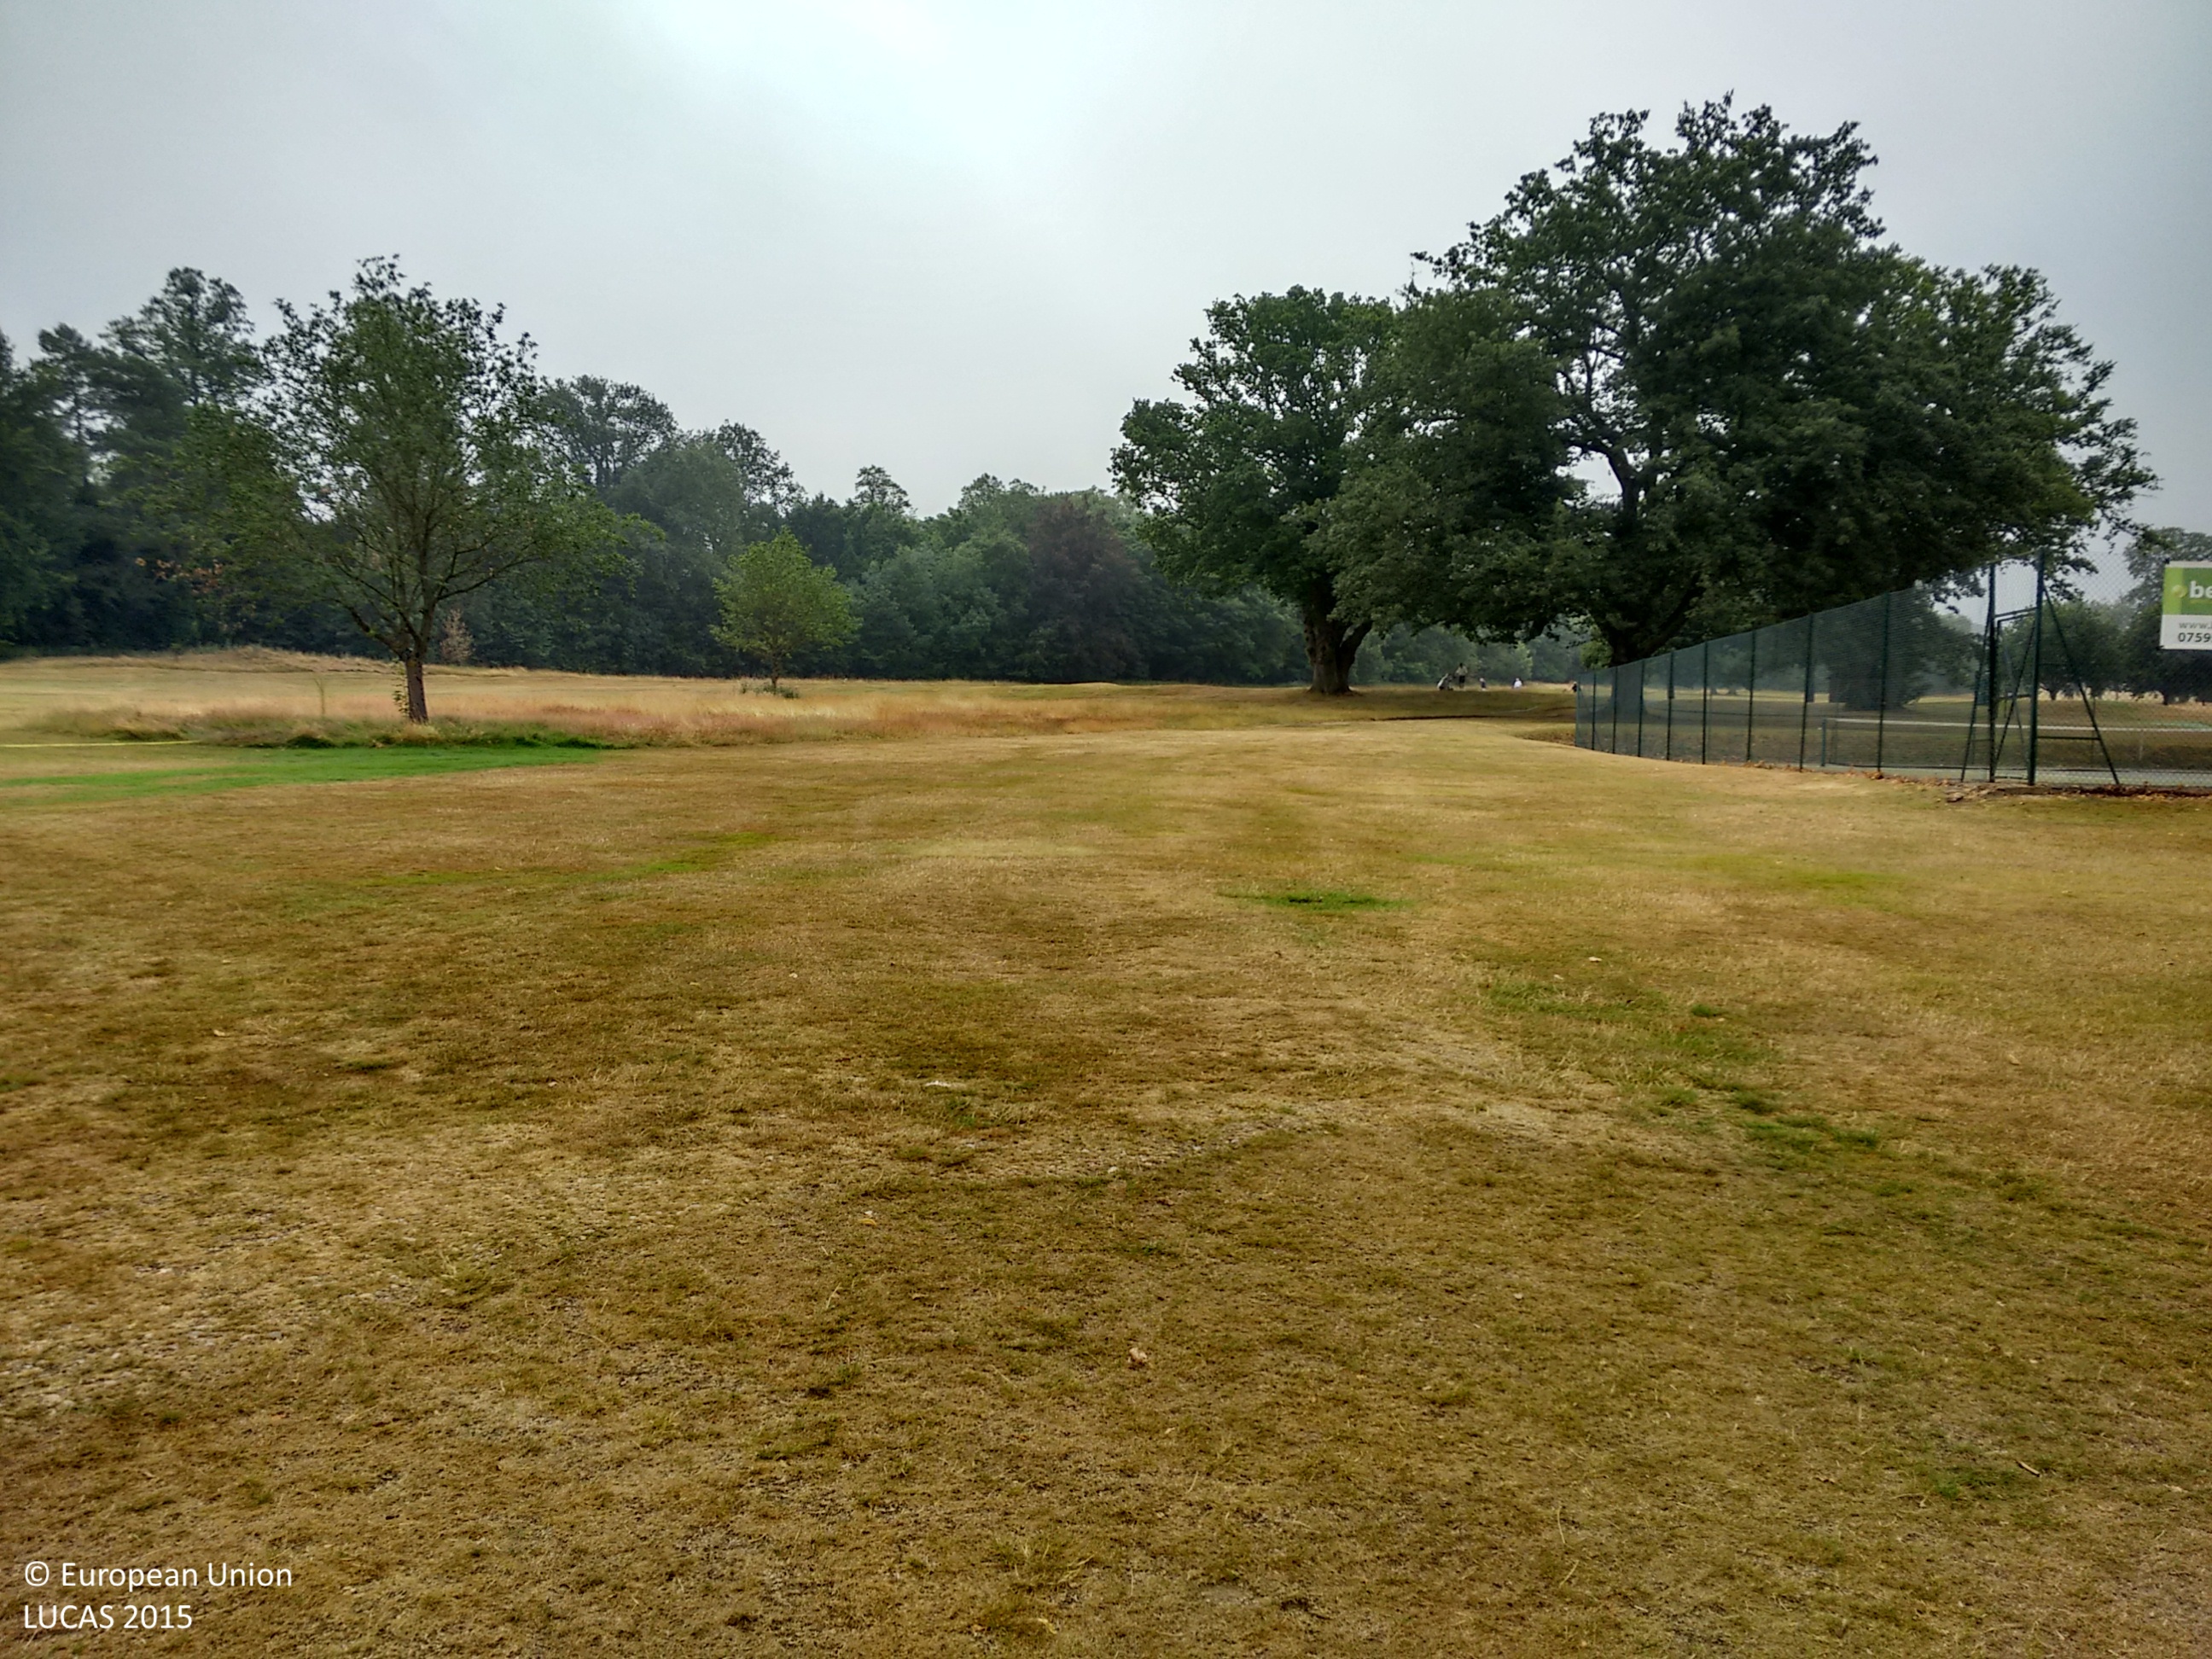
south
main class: Grassland
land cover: Grassland without tree/shrub cover
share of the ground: > 75 %
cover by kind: herbaceous plants 100 %
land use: Sport
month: July
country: GB
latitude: 51.2667
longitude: -0.3994
